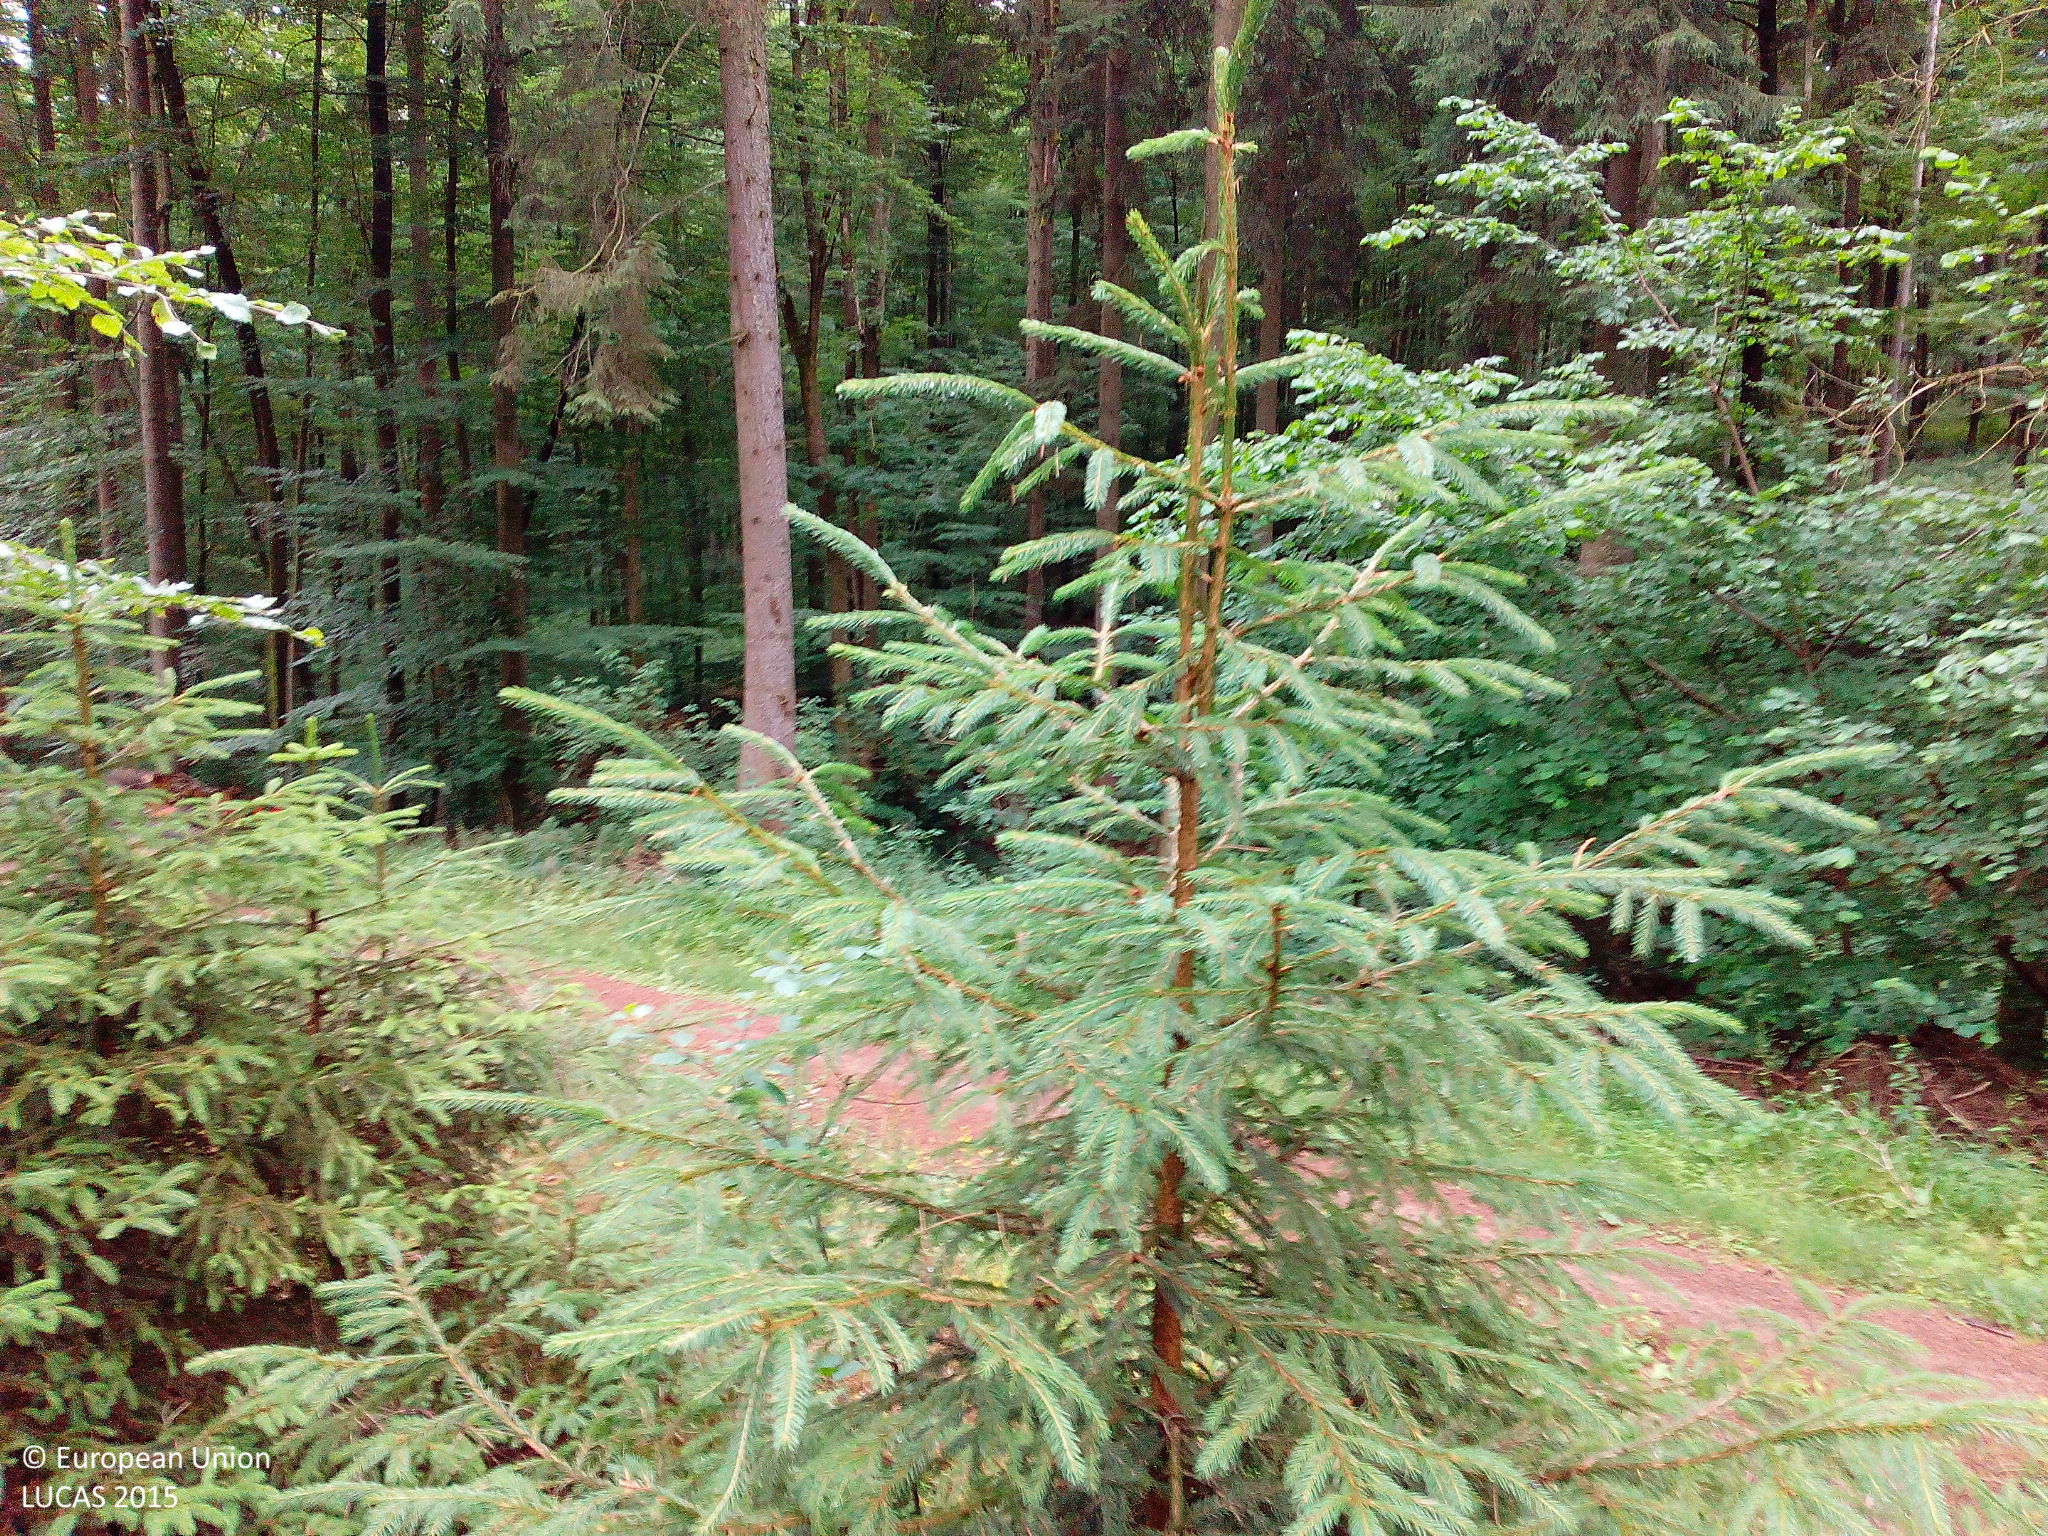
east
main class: Woodland
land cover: Spruce dominated mixed woodland
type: hemiboreal forest and nemoral coniferous forest and mixed broadleaved-coniferous forest
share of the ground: > 75 %
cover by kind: coniferous forest trees 40 %, broadleaved forest trees 30 %, unconsolidated bare surface 20 %, herbaceous plants 5 %, lichens and mosses 5 %
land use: Forestry
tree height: > 5 m
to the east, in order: Spruce dominated mixed woodland; Tracks; Spruce dominated mixed woodland; Ditches and canals; Spruce dominated mixed woodland; Broadleaved woodland
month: July
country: DE
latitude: 51.0292
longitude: 9.8717
